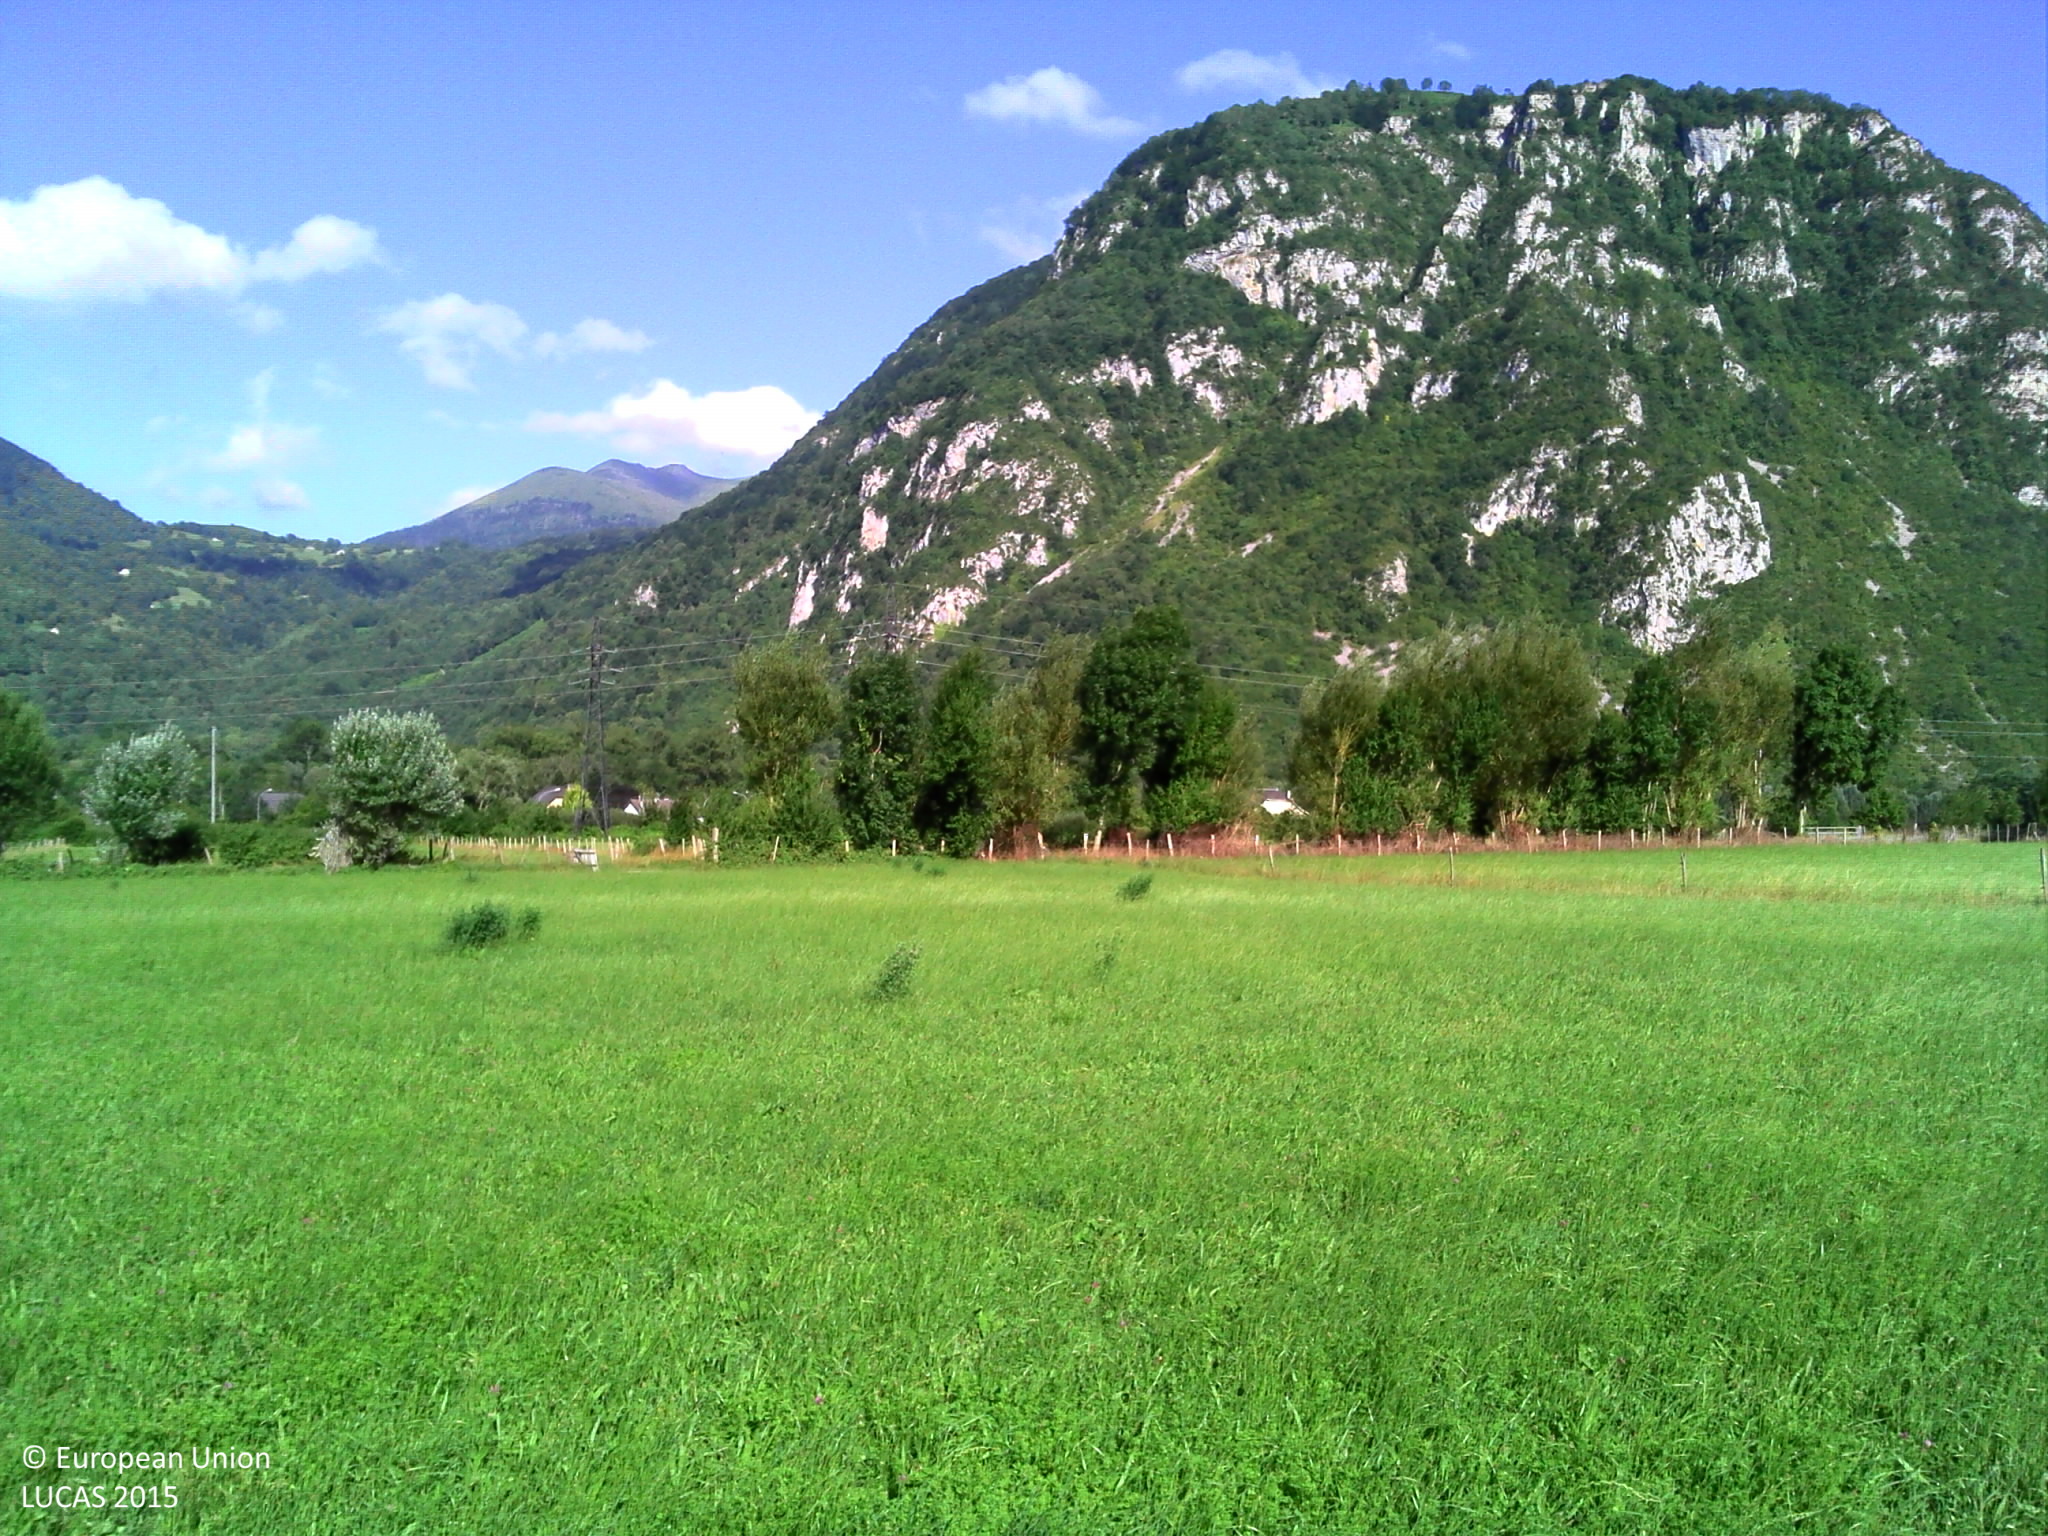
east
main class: Grassland
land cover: Grassland without tree/shrub cover
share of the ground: > 75 %
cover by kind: herbaceous plants 100 %
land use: Agriculture (excluding fallow land and kitchen gardens)
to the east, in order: Grassland without tree/shrub cover; Fences; Tracks; Fences; Grassland without tree/shrub cover; Fences; Single bushes/trees; Grassland without tree/shrub cover; Electric lines; Grassland without tree/shrub cover; Electric lines; Shrubland with sparse tree cover; Dry stone walls; Grass margins; Paved roads, cycling and walking lanes; Grassland without tree/shrub cover
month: July
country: FR
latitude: 43.0600
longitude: -0.4301
